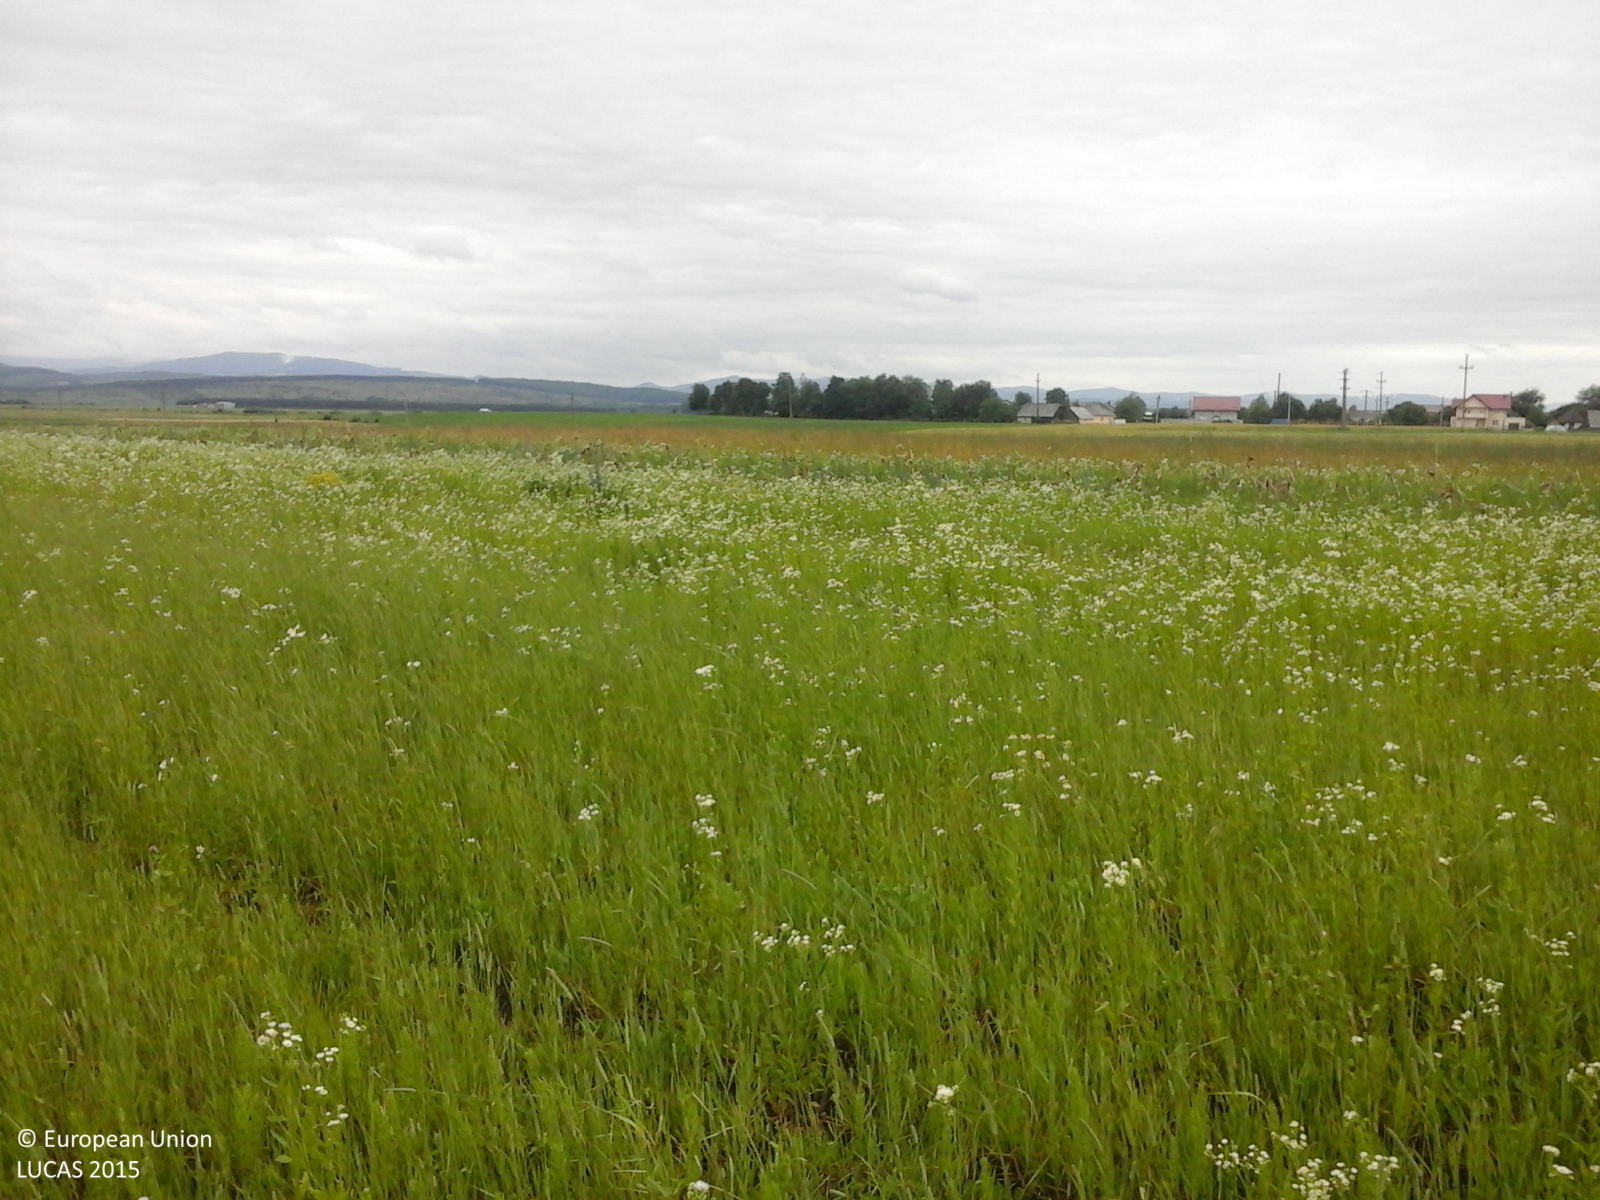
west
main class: Grassland
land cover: Grassland without tree/shrub cover
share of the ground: > 75 %
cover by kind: herbaceous plants 100 %
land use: Agriculture (excluding fallow land and kitchen gardens)
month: June
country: RO
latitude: 47.4557
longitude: 26.1963
